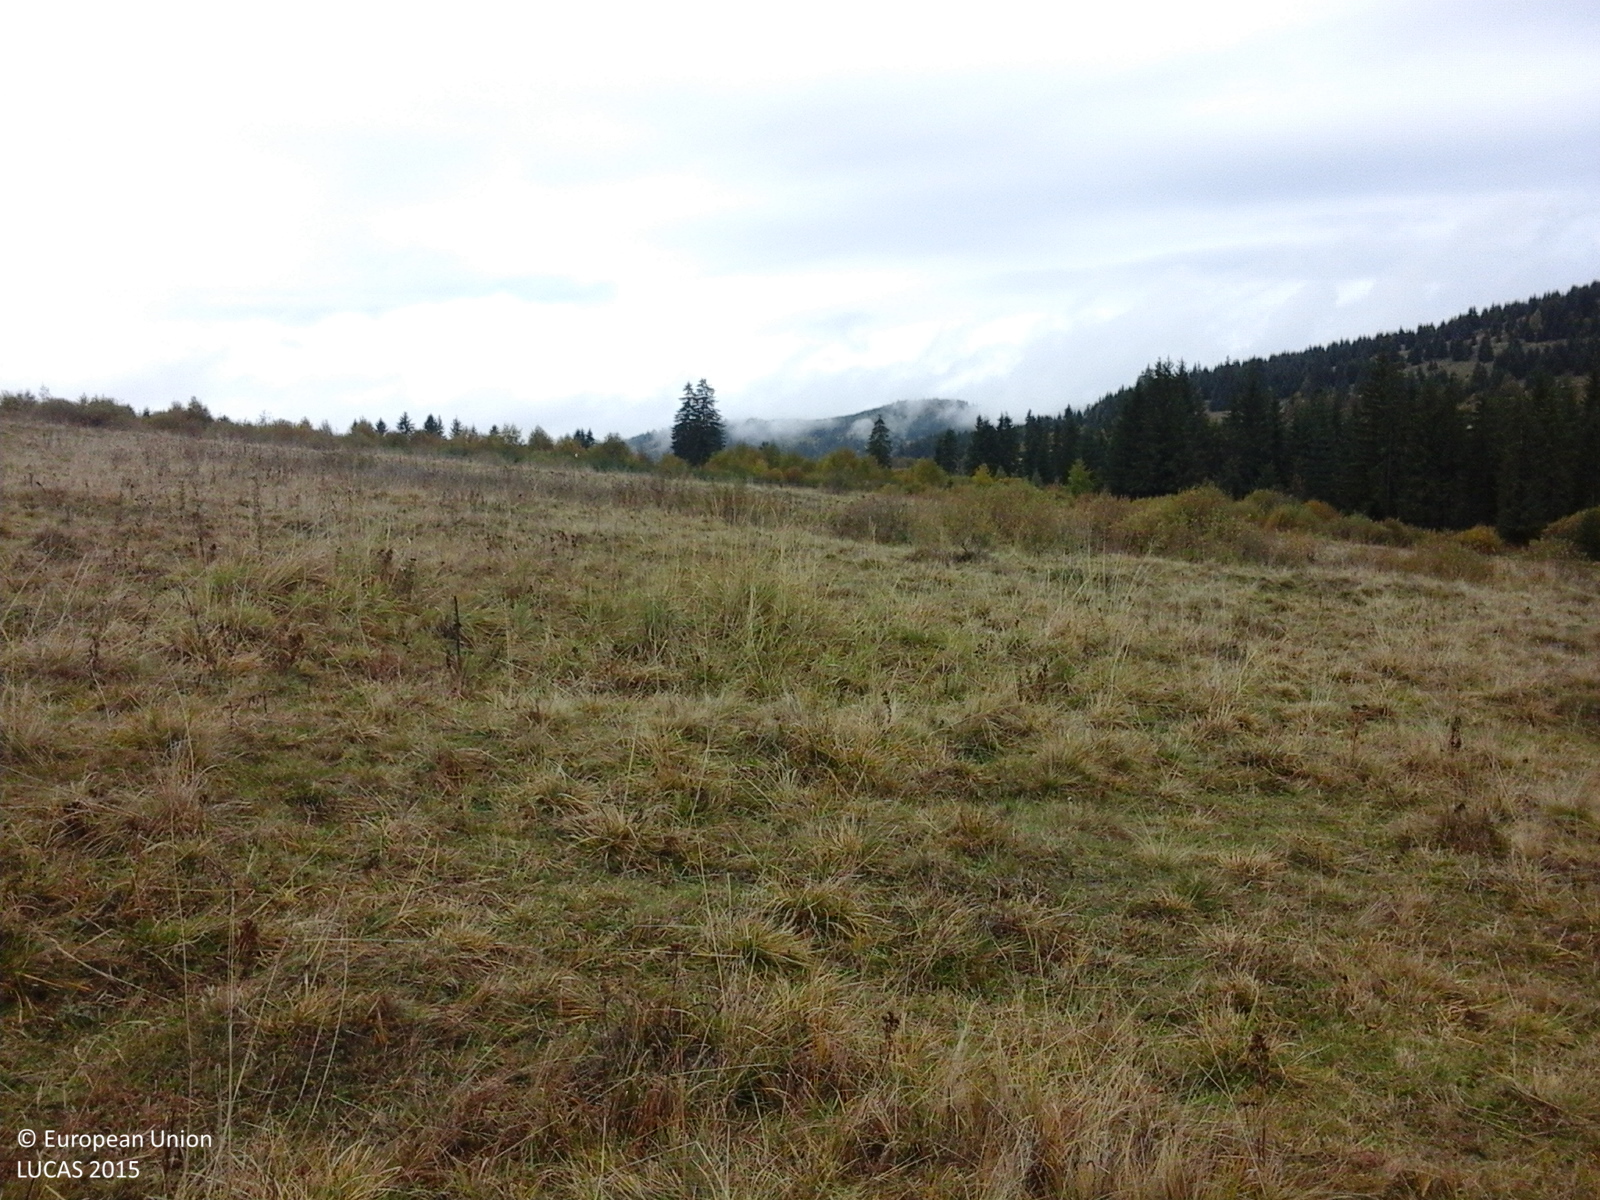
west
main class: Grassland
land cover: Grassland without tree/shrub cover
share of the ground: > 75 %
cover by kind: herbaceous plants 100 %
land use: Agriculture (excluding fallow land and kitchen gardens)
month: October
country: RO
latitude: 46.8648
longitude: 25.6066
